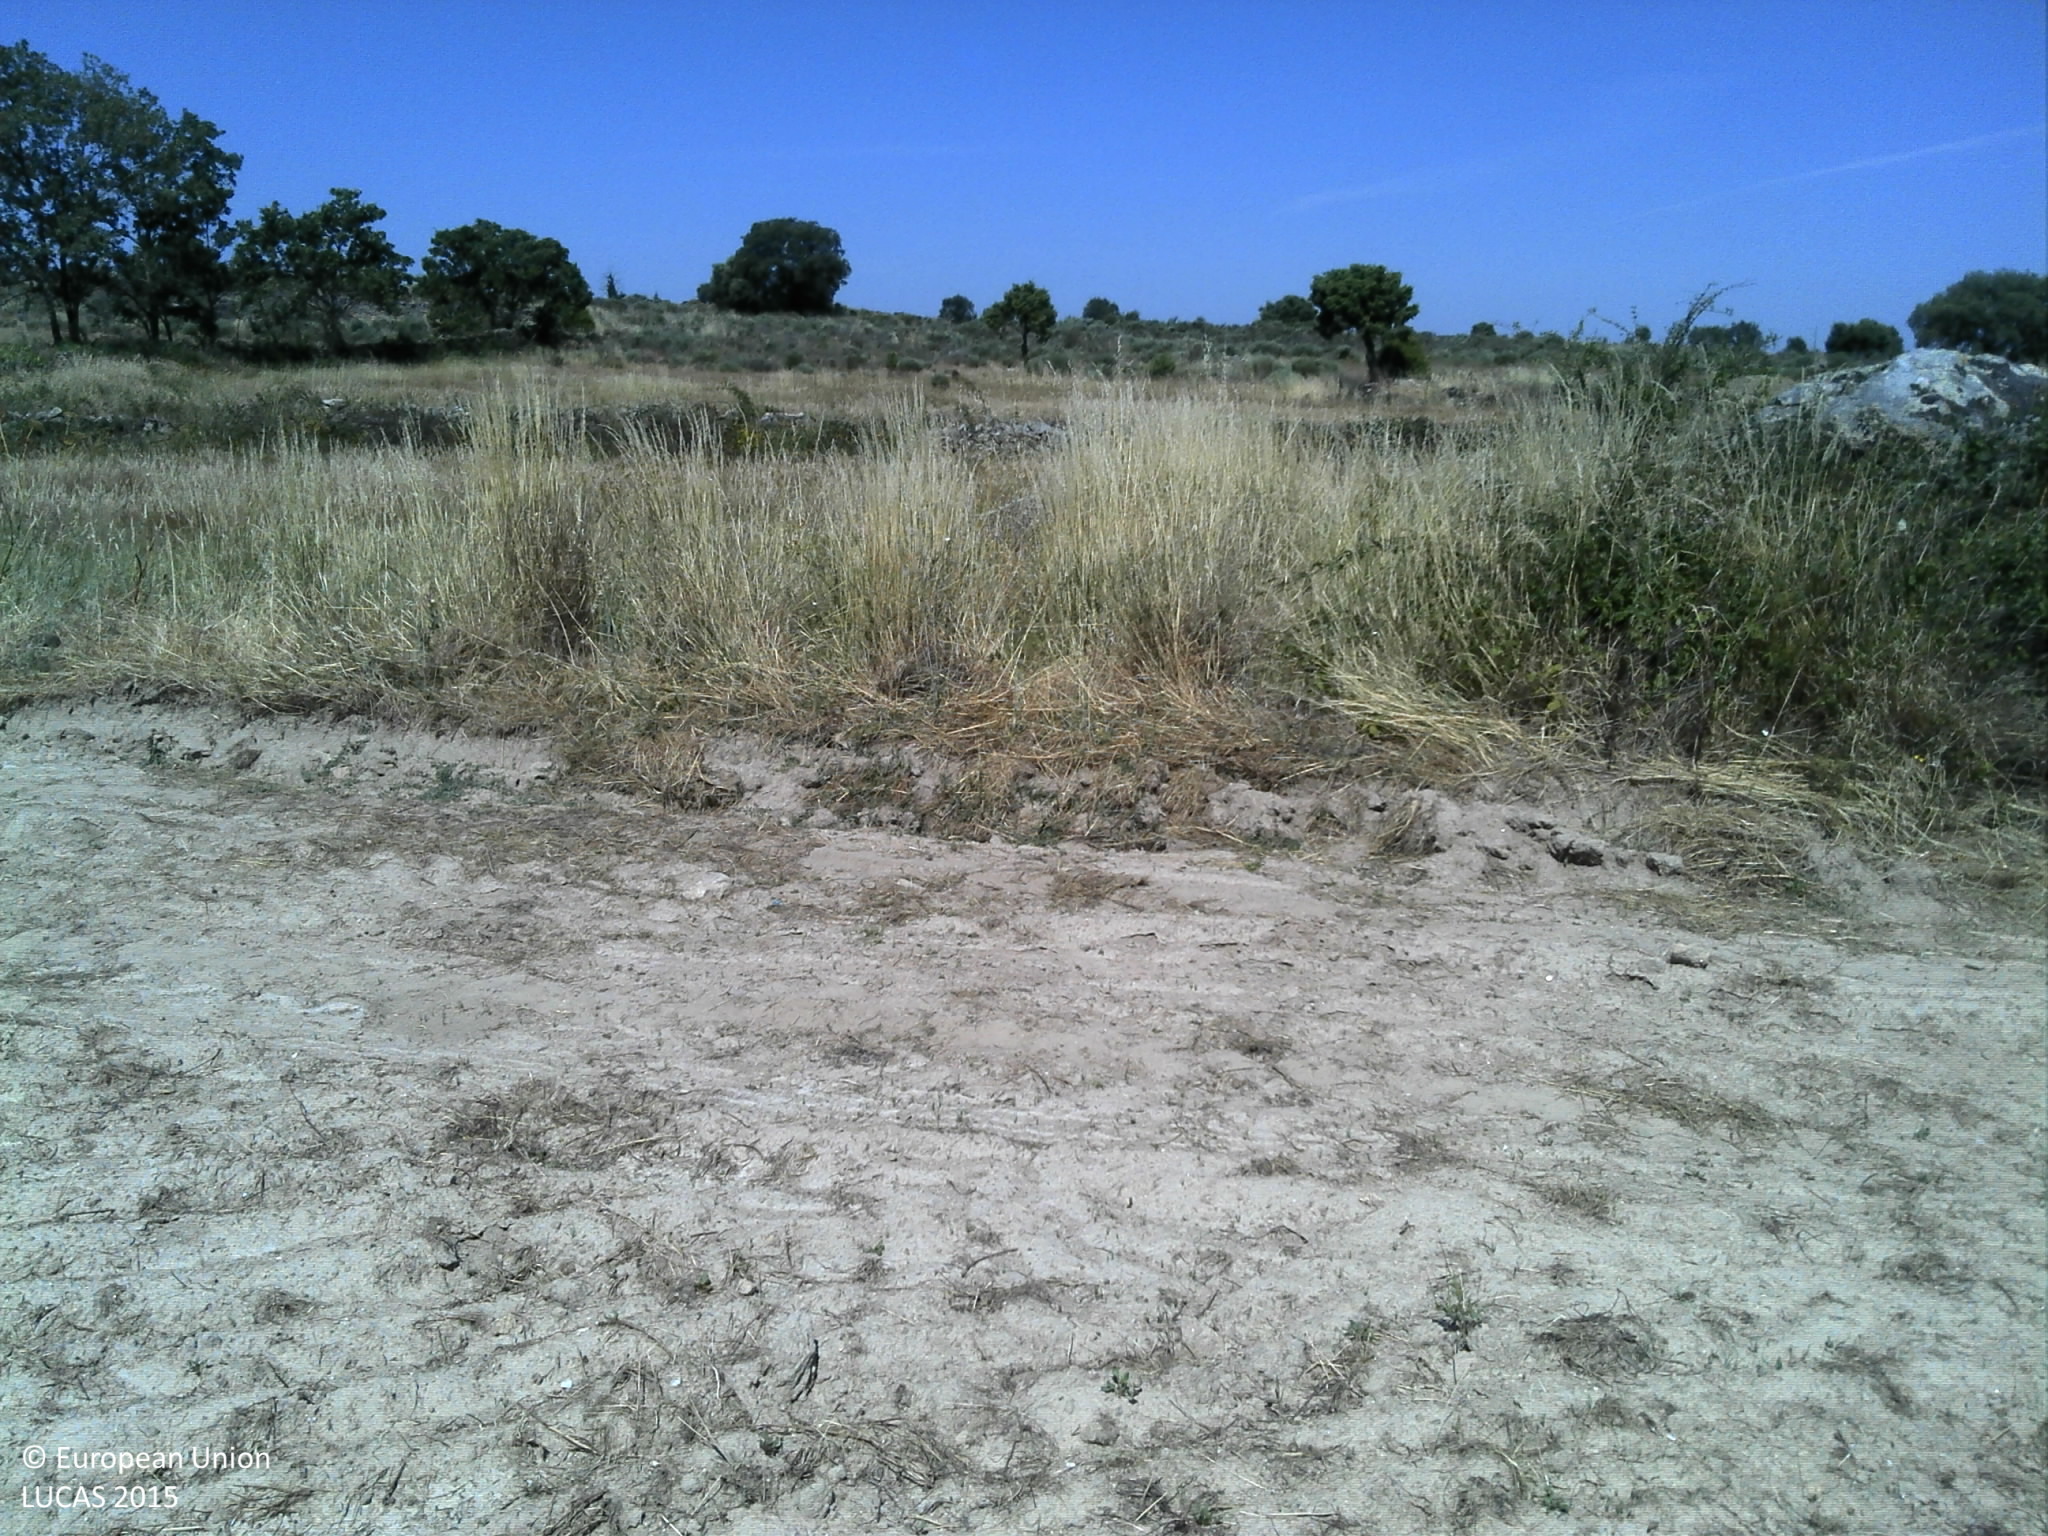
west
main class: Cropland
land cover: Durum wheat
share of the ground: < 10 %
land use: Agriculture (excluding fallow land and kitchen gardens)
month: June
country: PT
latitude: 40.9611
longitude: -6.9166
